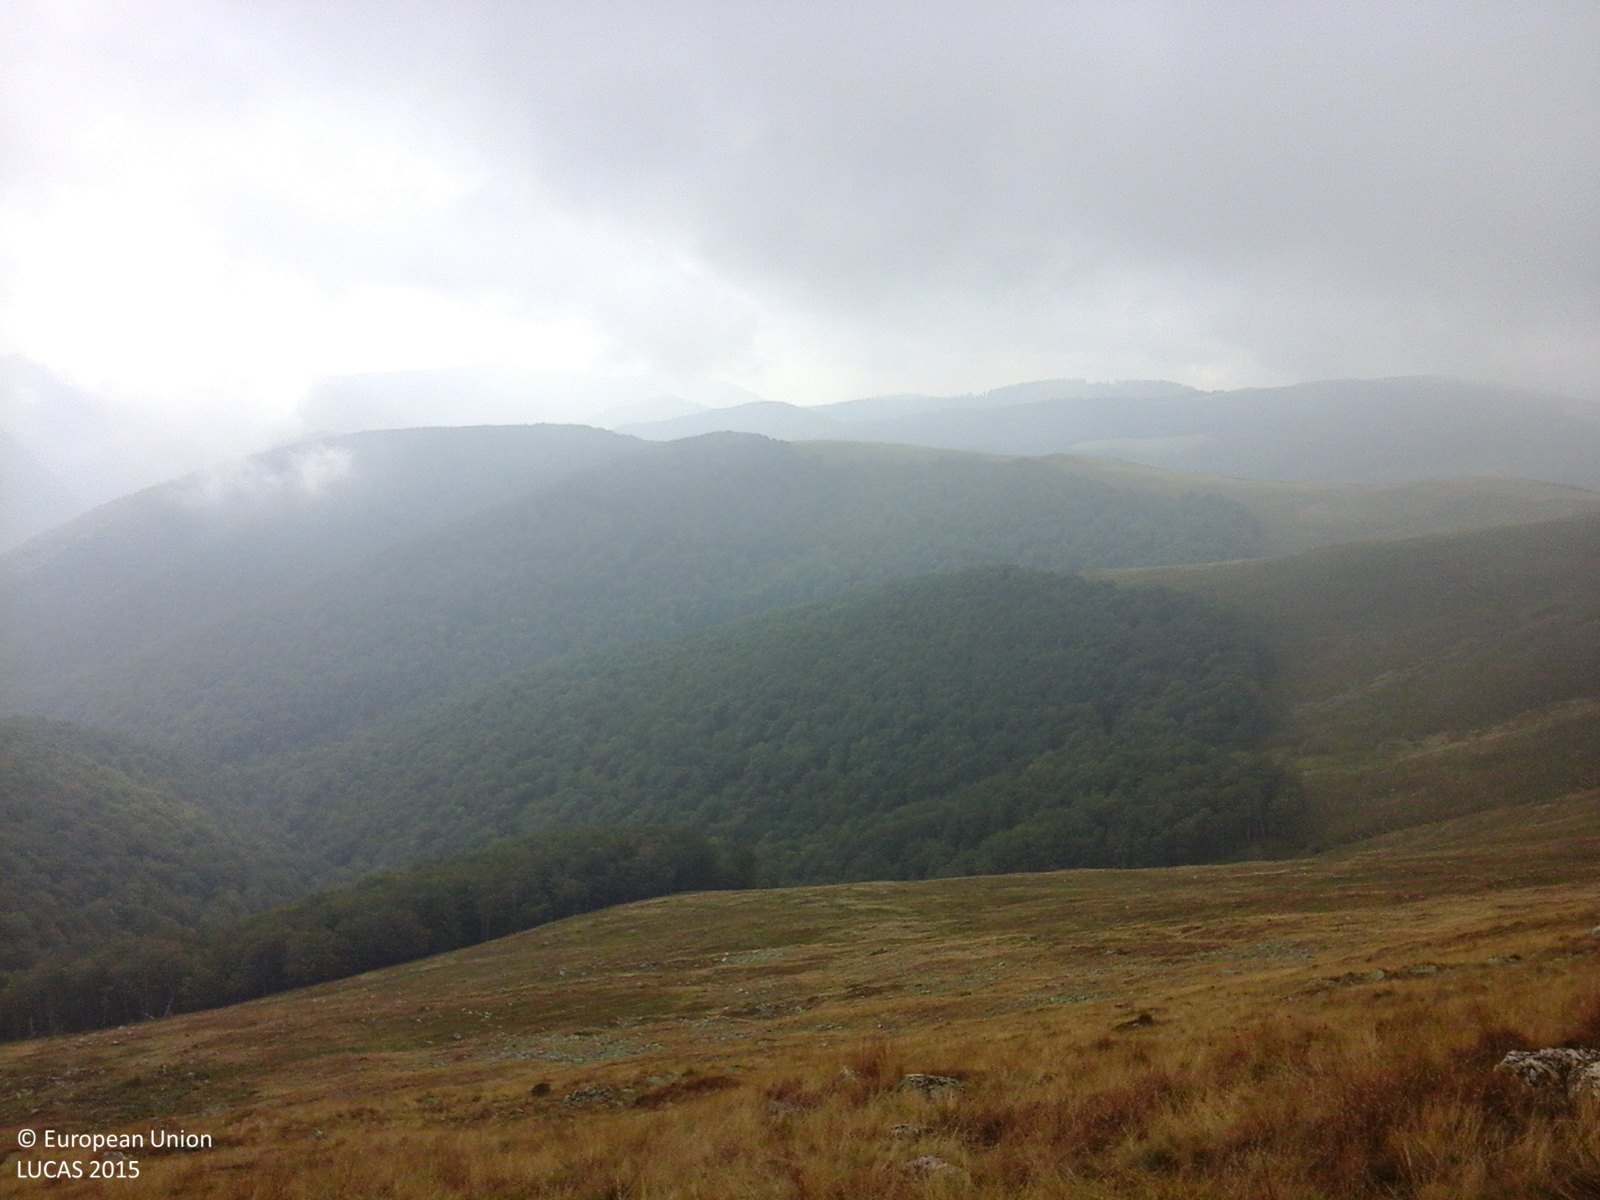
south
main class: Grassland
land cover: Grassland without tree/shrub cover
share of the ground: > 75 %
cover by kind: herbaceous plants 100 %
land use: Agriculture (excluding fallow land and kitchen gardens)
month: September
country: RO
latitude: 45.2966
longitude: 23.3054
